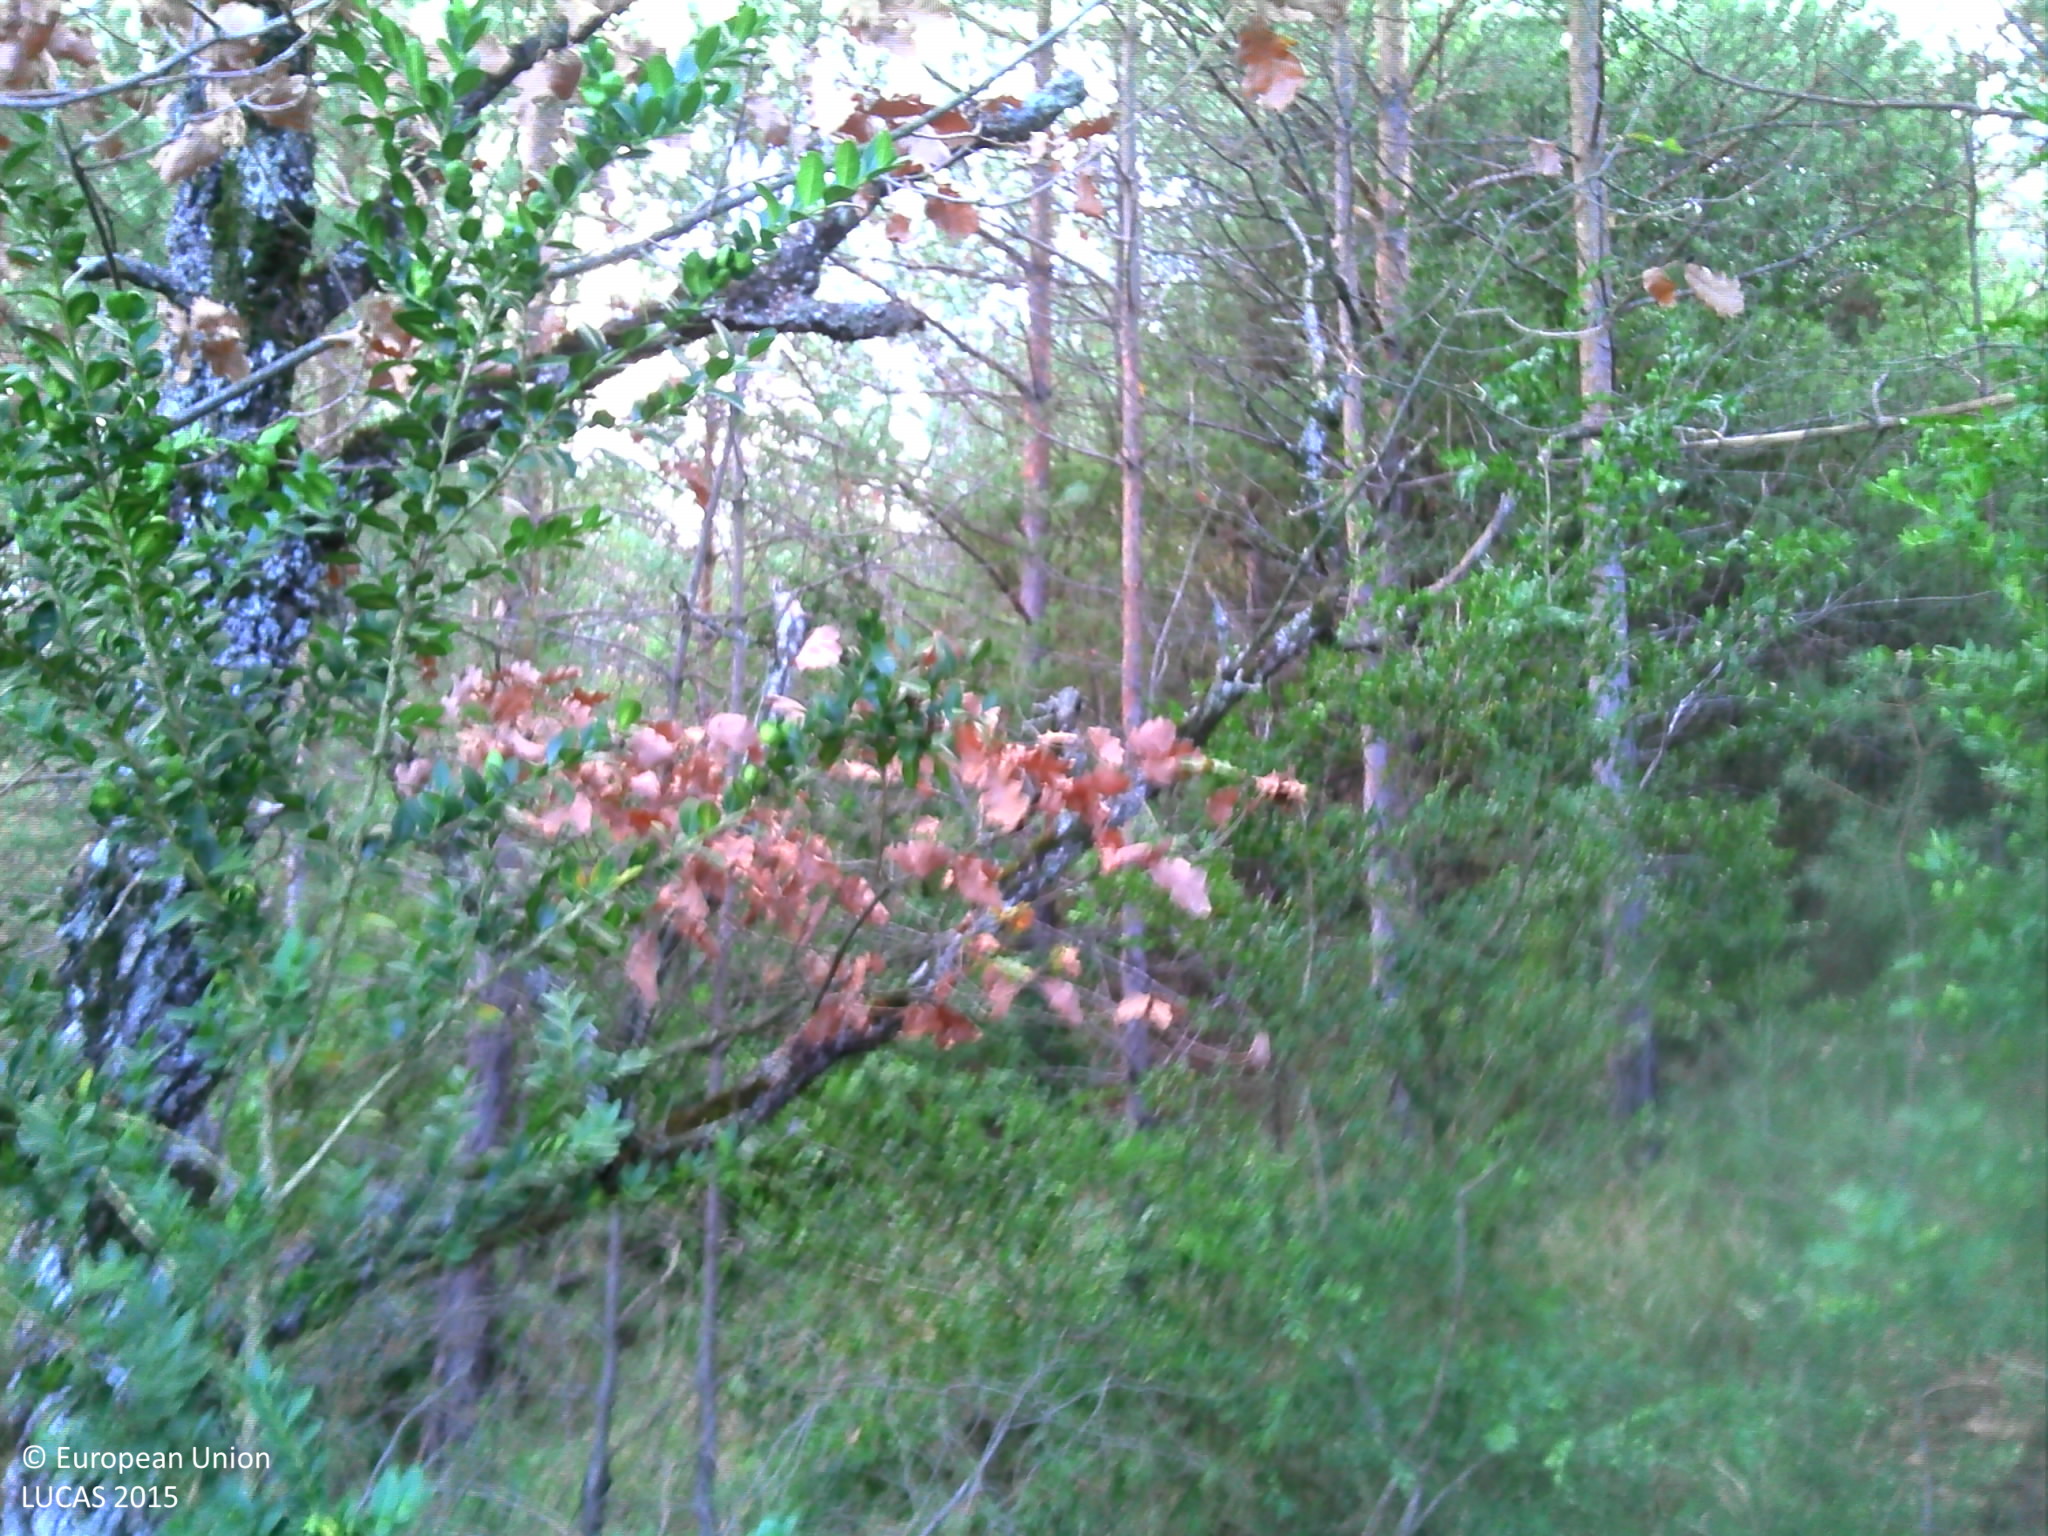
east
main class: Woodland
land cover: Pine dominated mixed woodland
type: thermophilous deciduous forest
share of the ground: > 75 %
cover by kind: coniferous forest trees 60 %, broadleaved forest trees 20 %, shrubs 10 %, herbaceous plants 10 %
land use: Forestry
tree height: > 5 m
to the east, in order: Pine dominated mixed woodland; Rock outcrops; Pine dominated mixed woodland
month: November
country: FR
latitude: 43.9899
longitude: 3.3111
